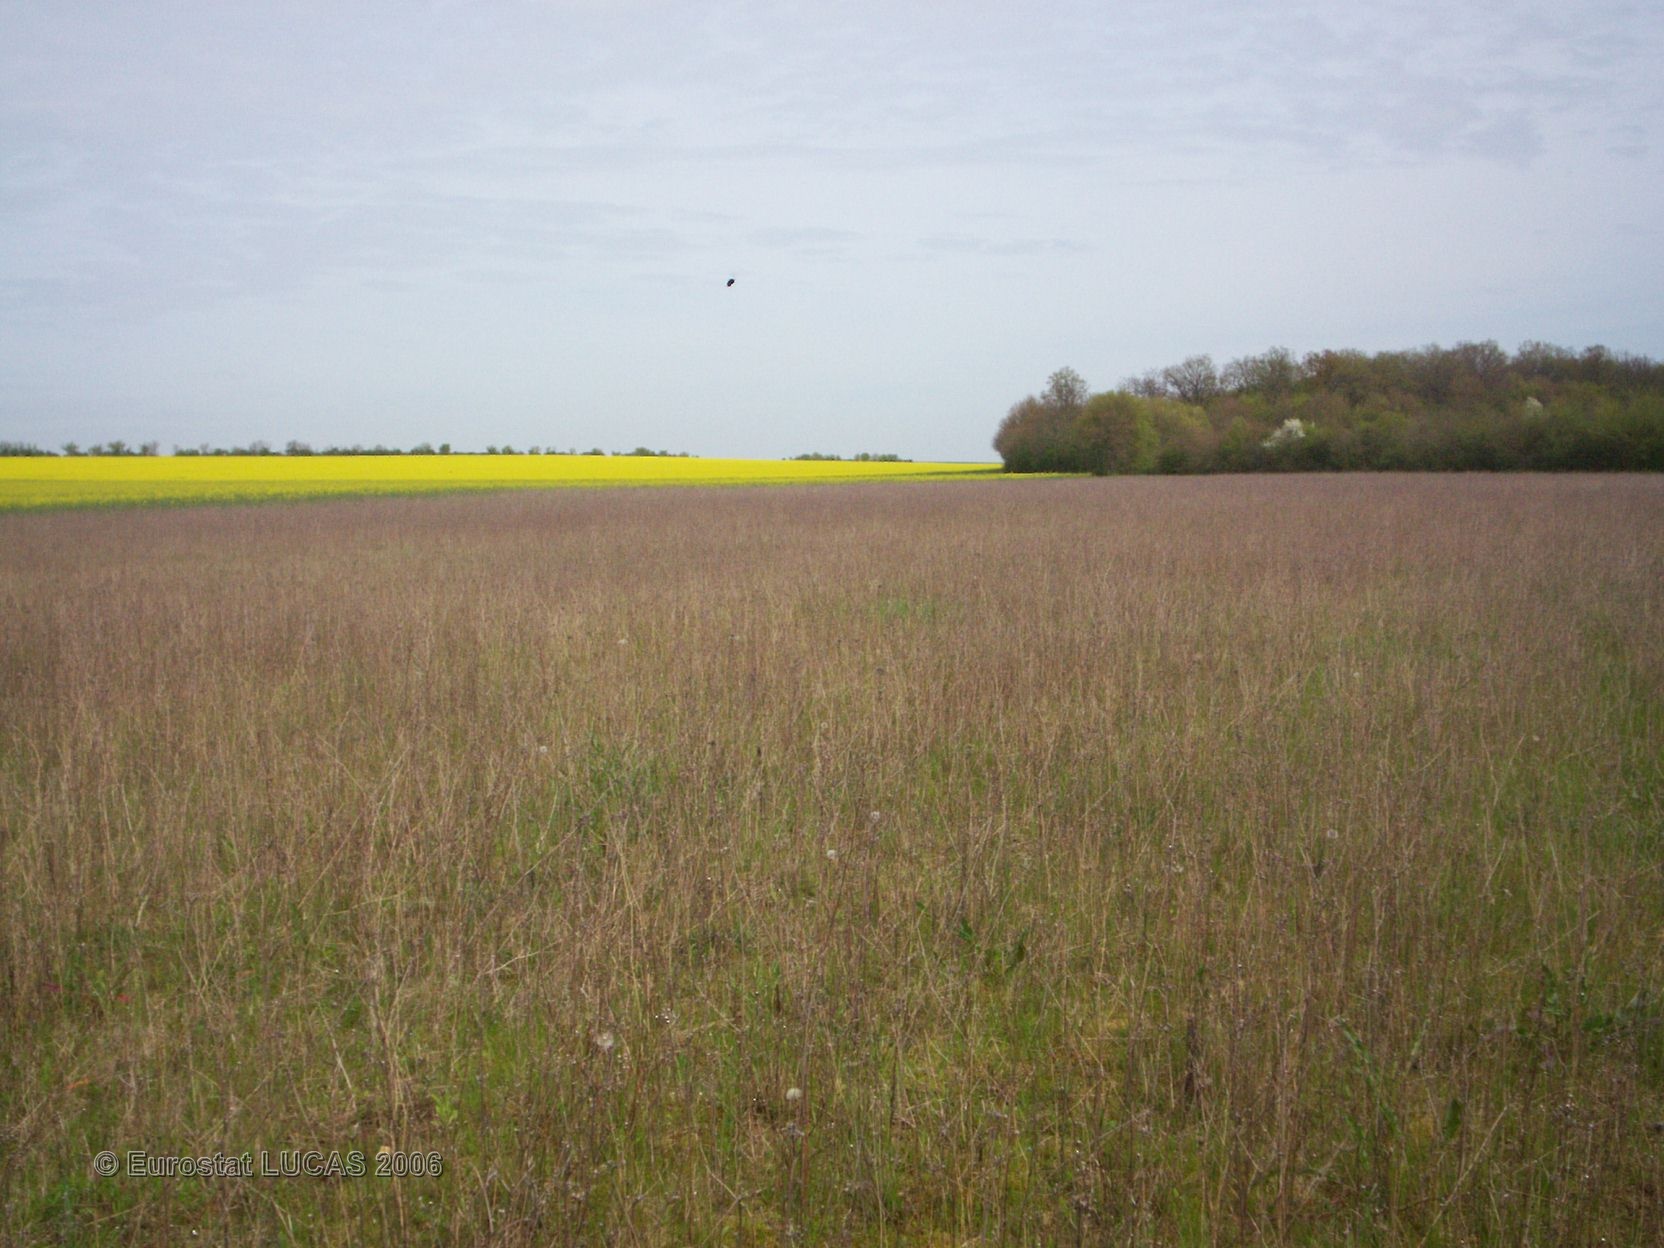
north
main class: Grassland
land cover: Grassland without tree/shrub cover
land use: Fallow land
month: May
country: FR
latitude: 47.2835
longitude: 3.0806
